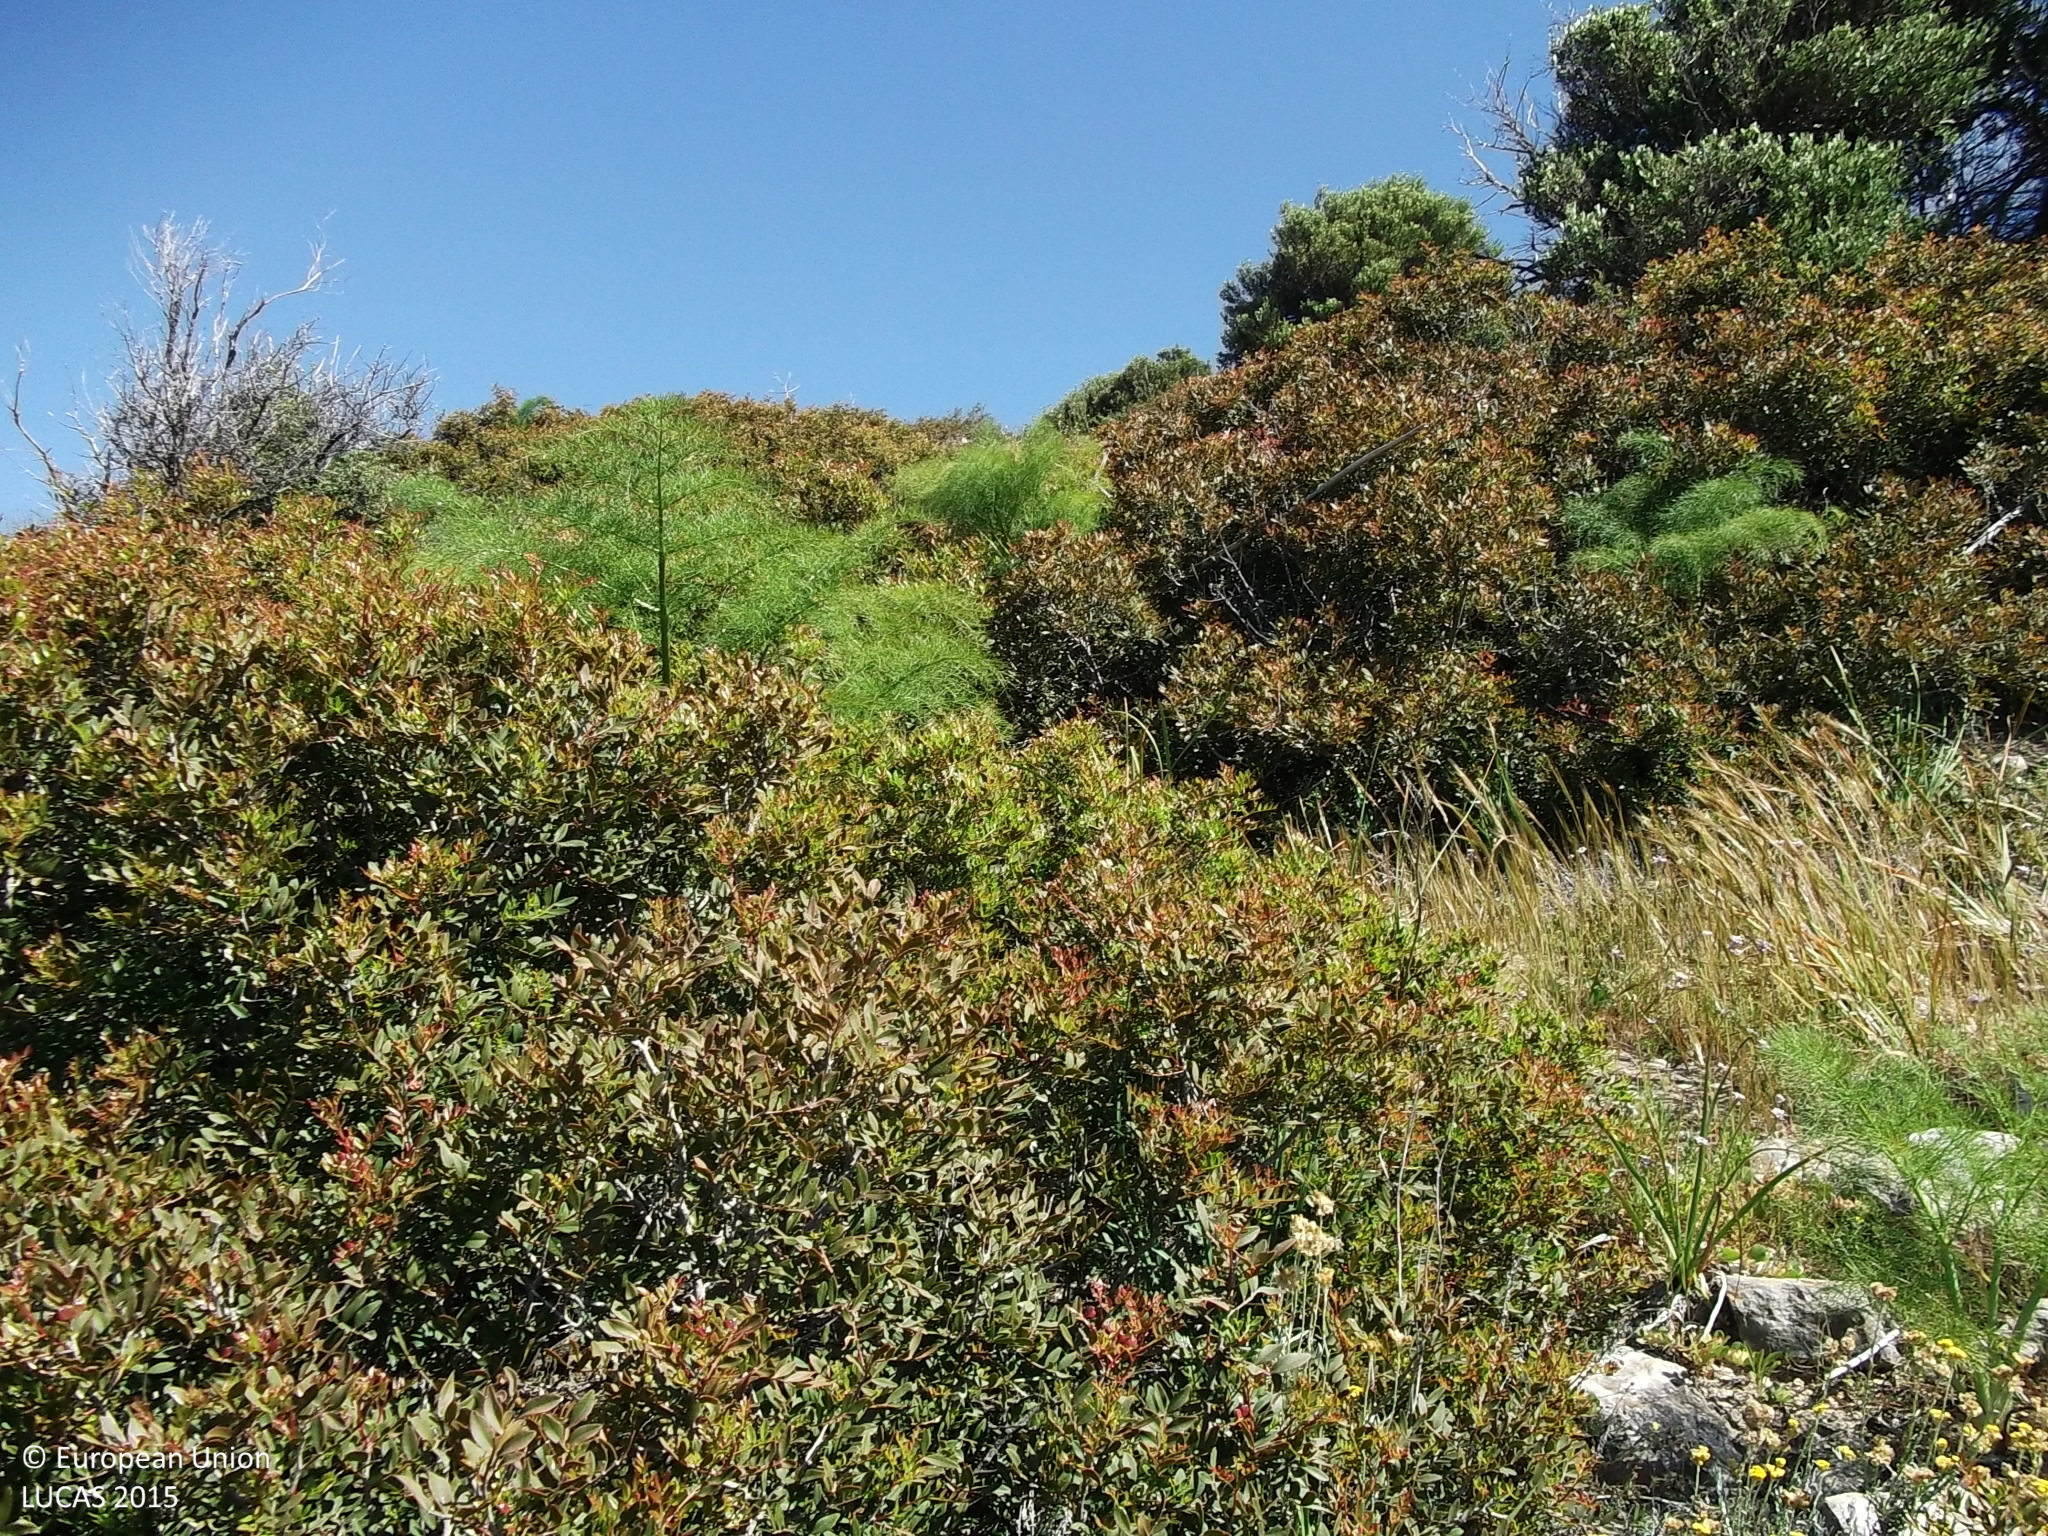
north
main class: Shrubland
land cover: Shrubland with sparse tree cover
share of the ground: 50 - 75 %
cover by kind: shrubs 45 %, herbaceous plants 40 %, unconsolidated bare surface 10 %, broadleaved forest trees 5 %
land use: Semi-natural and natural areas not in use
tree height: < 5 m
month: April
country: CY
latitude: 34.7833
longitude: 33.4046
